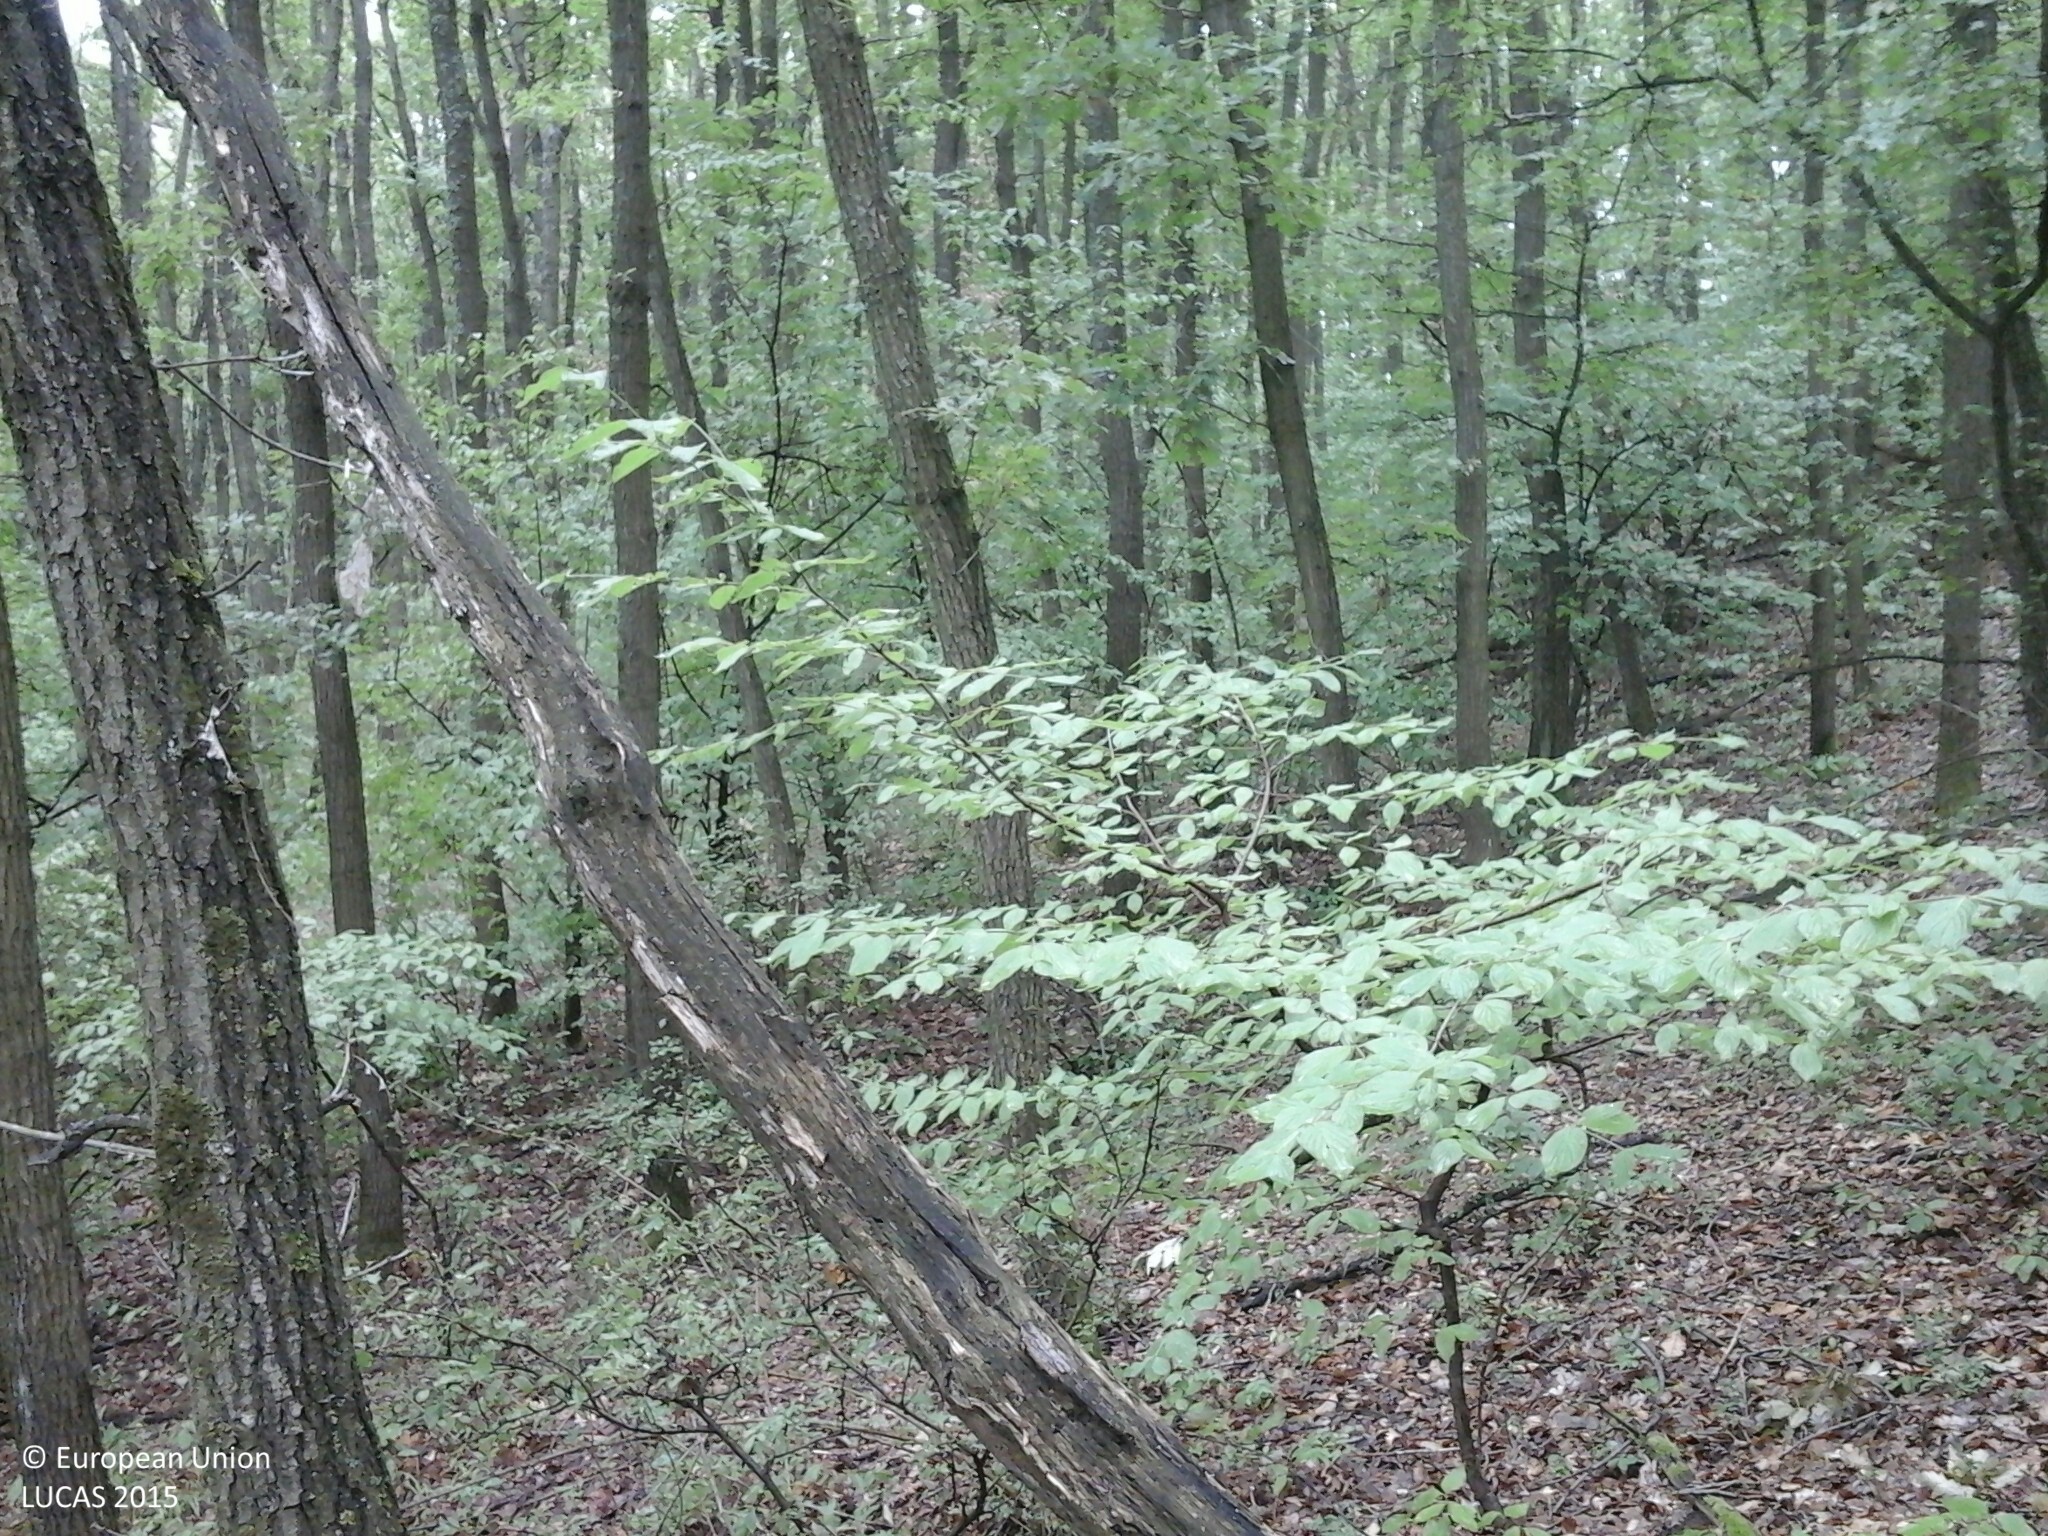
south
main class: Woodland
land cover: Broadleaved woodland
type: acidophilous oak and oak-birch forest
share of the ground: > 75 %
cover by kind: broadleaved forest trees 85 %, shrubs 15 %
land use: Forestry
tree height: > 5 m
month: July
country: HU
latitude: 47.9700
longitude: 20.3589
